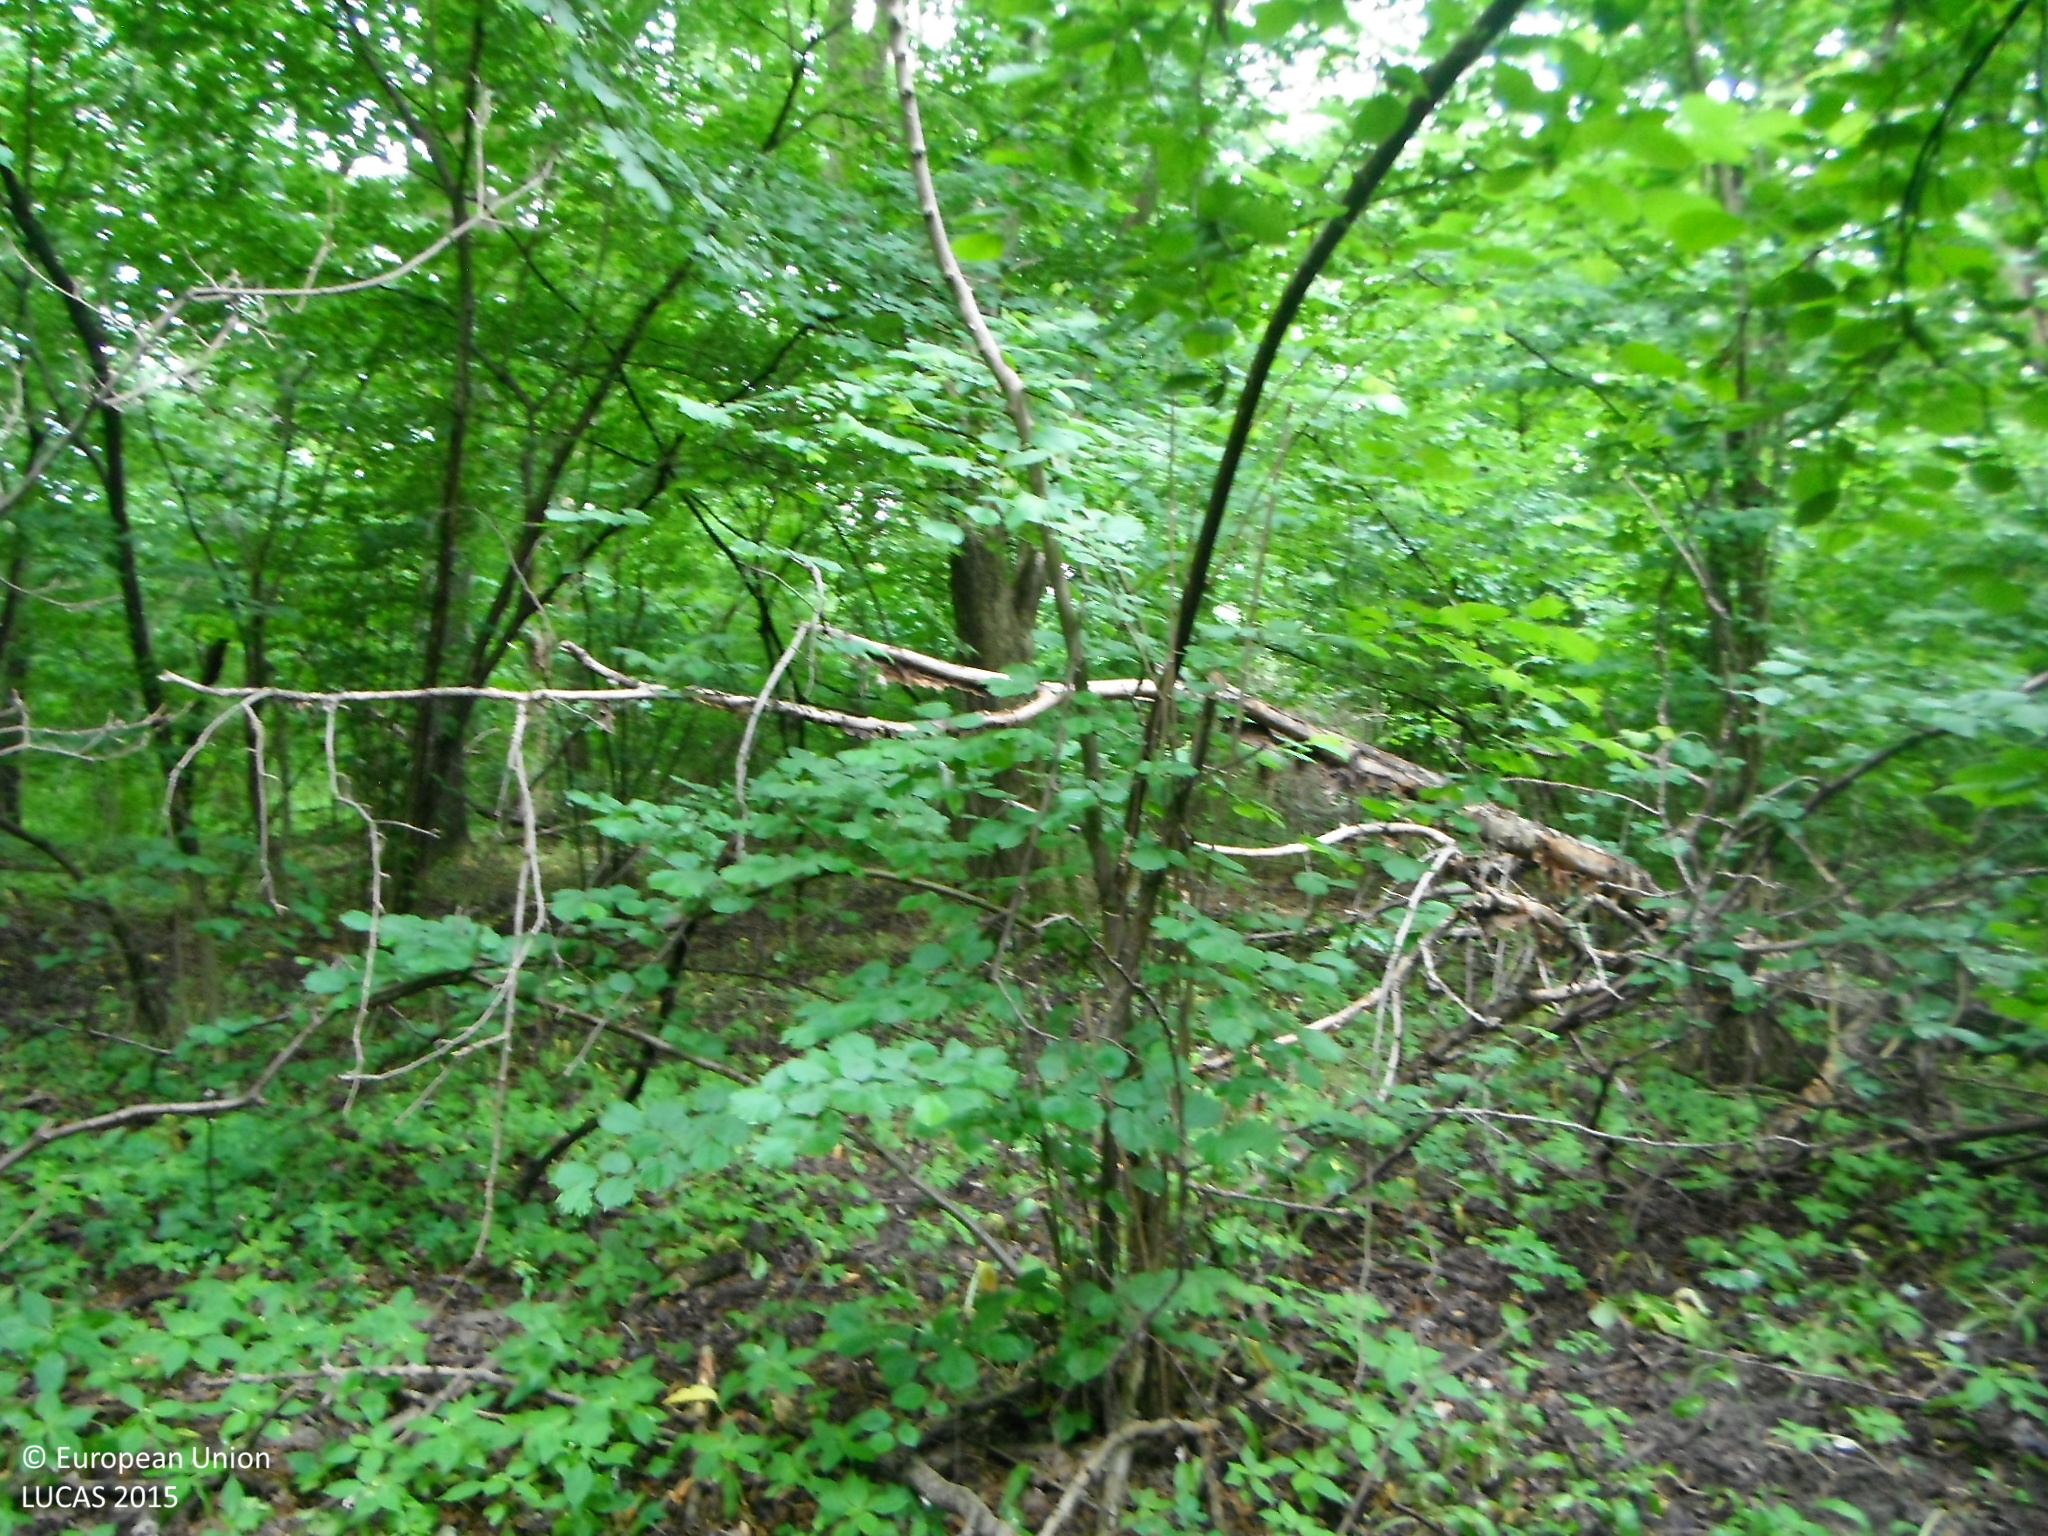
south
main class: Woodland
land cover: Broadleaved woodland
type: floodplain forest
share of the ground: > 75 %
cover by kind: broadleaved forest trees 90 %, herbaceous plants 10 %
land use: Forestry
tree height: > 5 m
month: June
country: SK
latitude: 48.0808
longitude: 17.1627
